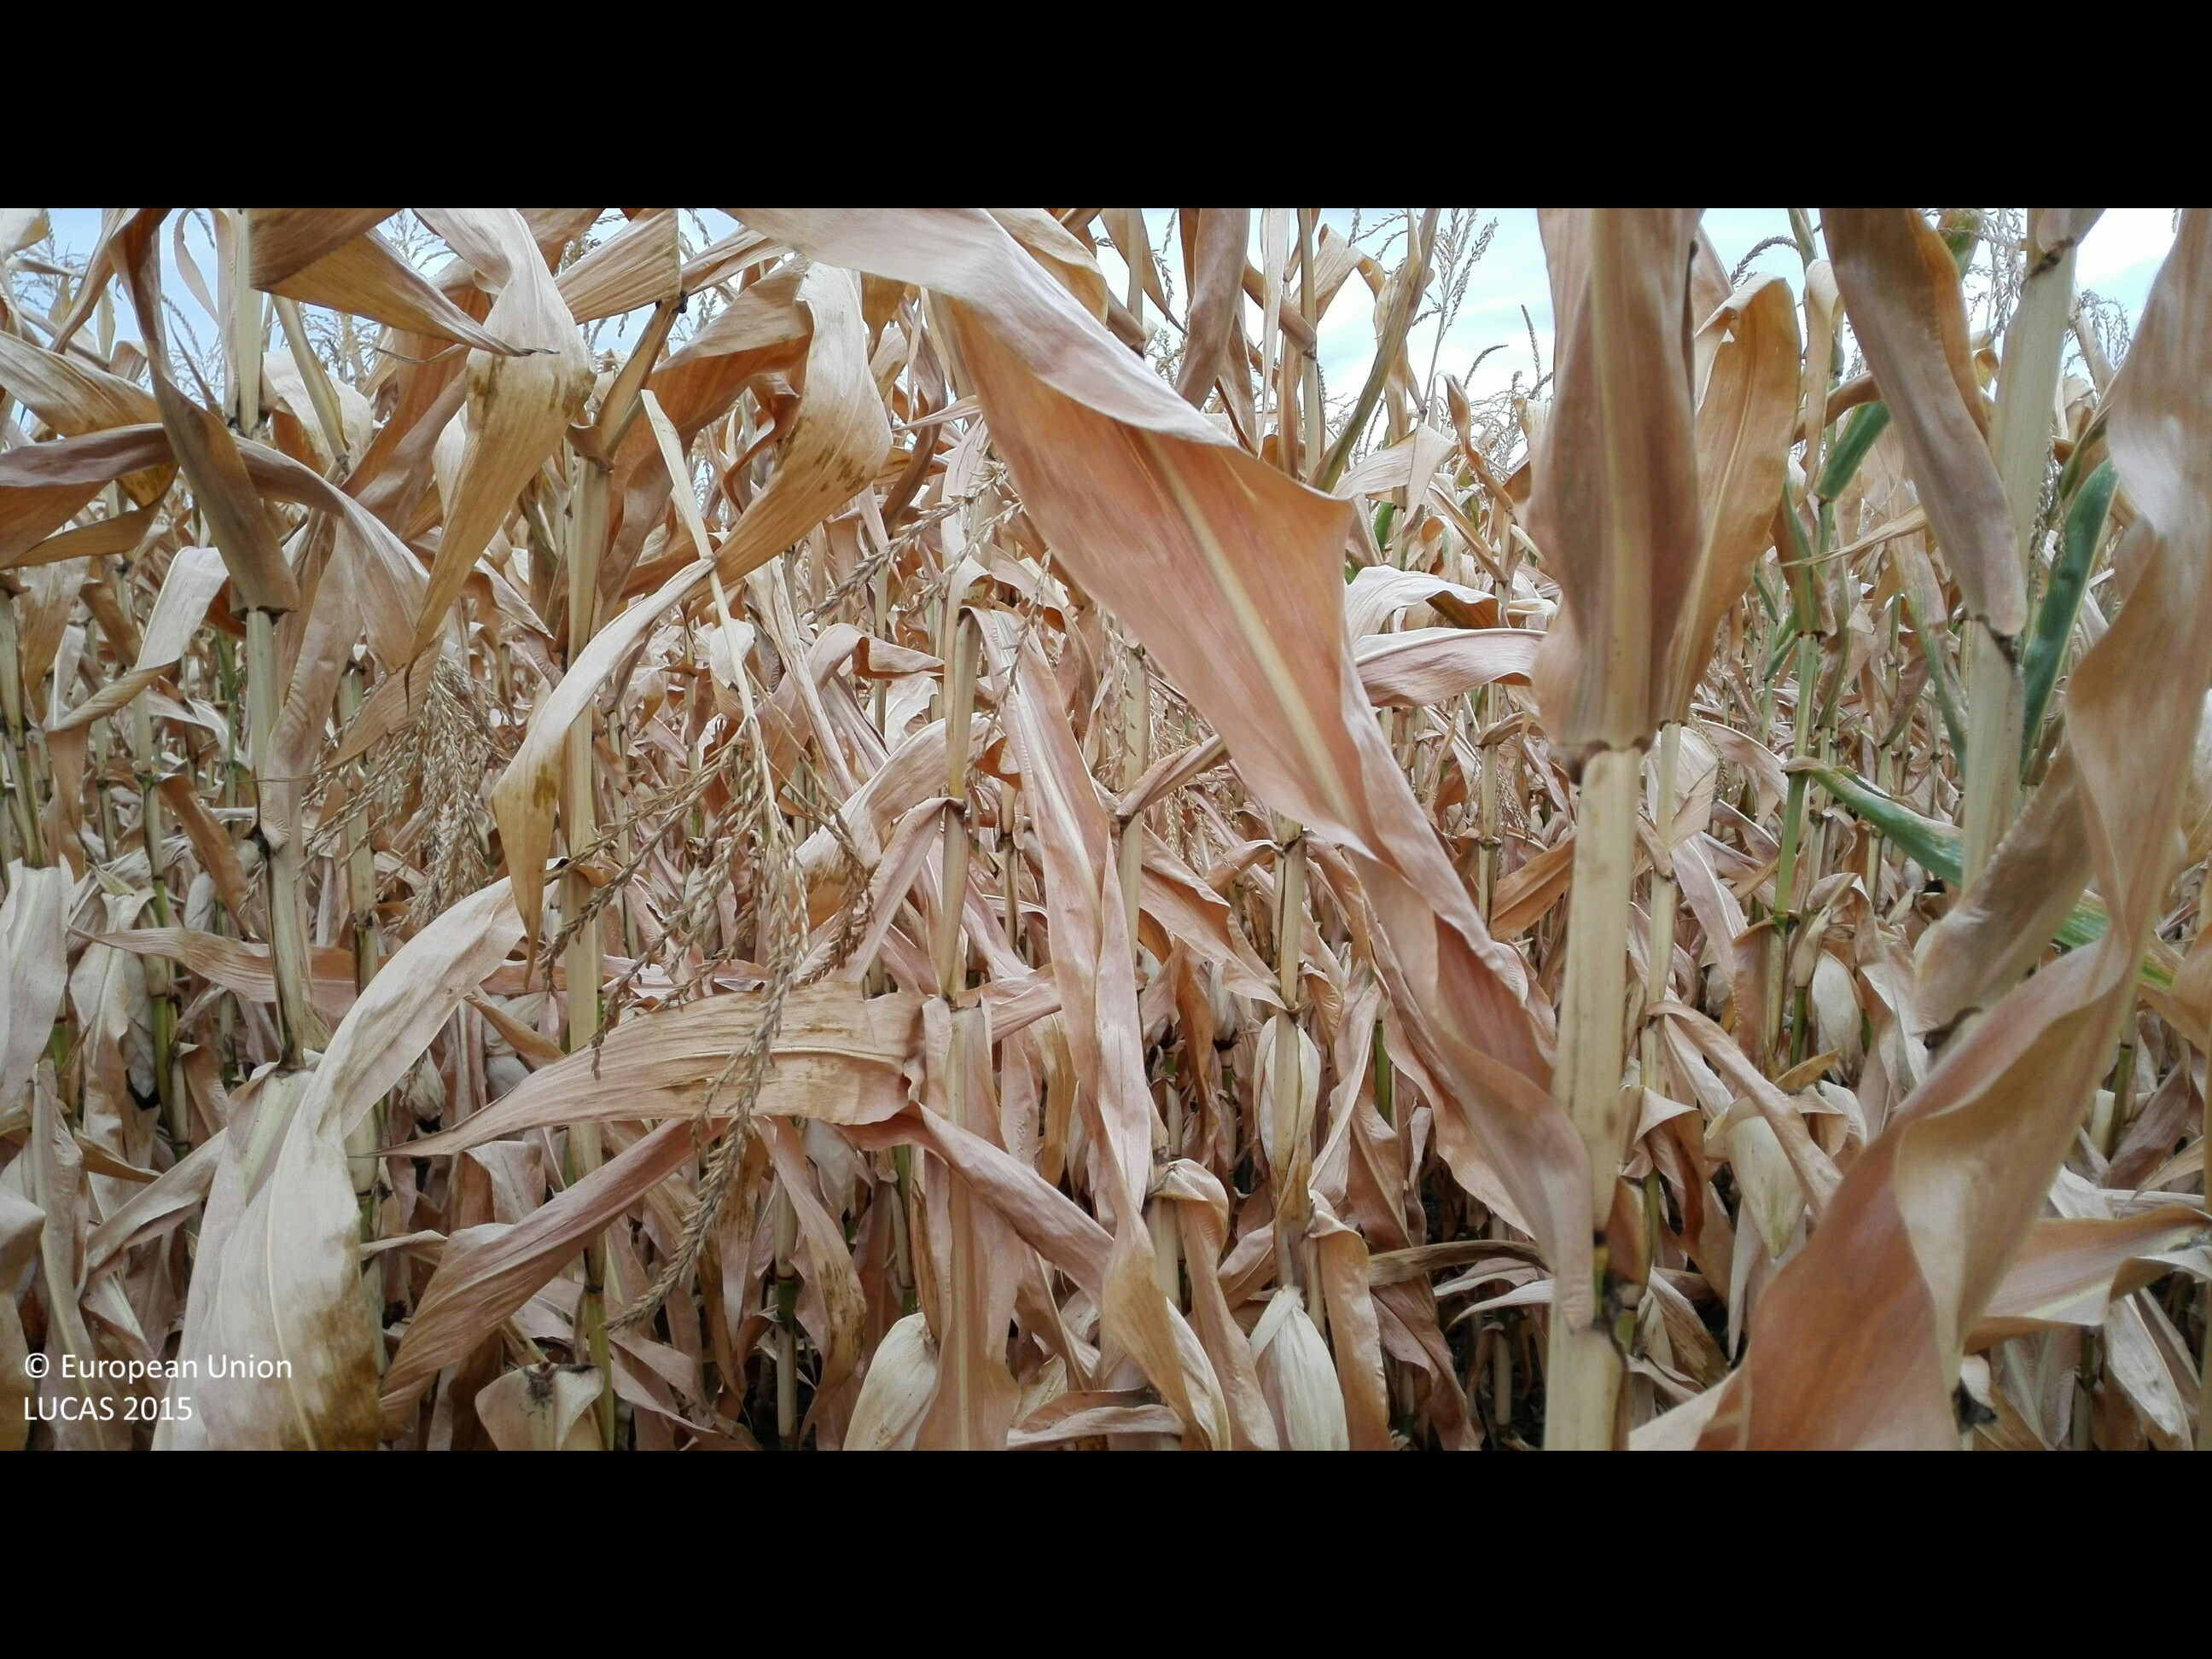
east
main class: Cropland
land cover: Maize
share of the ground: > 75 %
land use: Agriculture (excluding fallow land and kitchen gardens)
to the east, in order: Maize; Grassland without tree/shrub cover; Maize
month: August
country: HU
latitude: 47.3010
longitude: 21.5888
